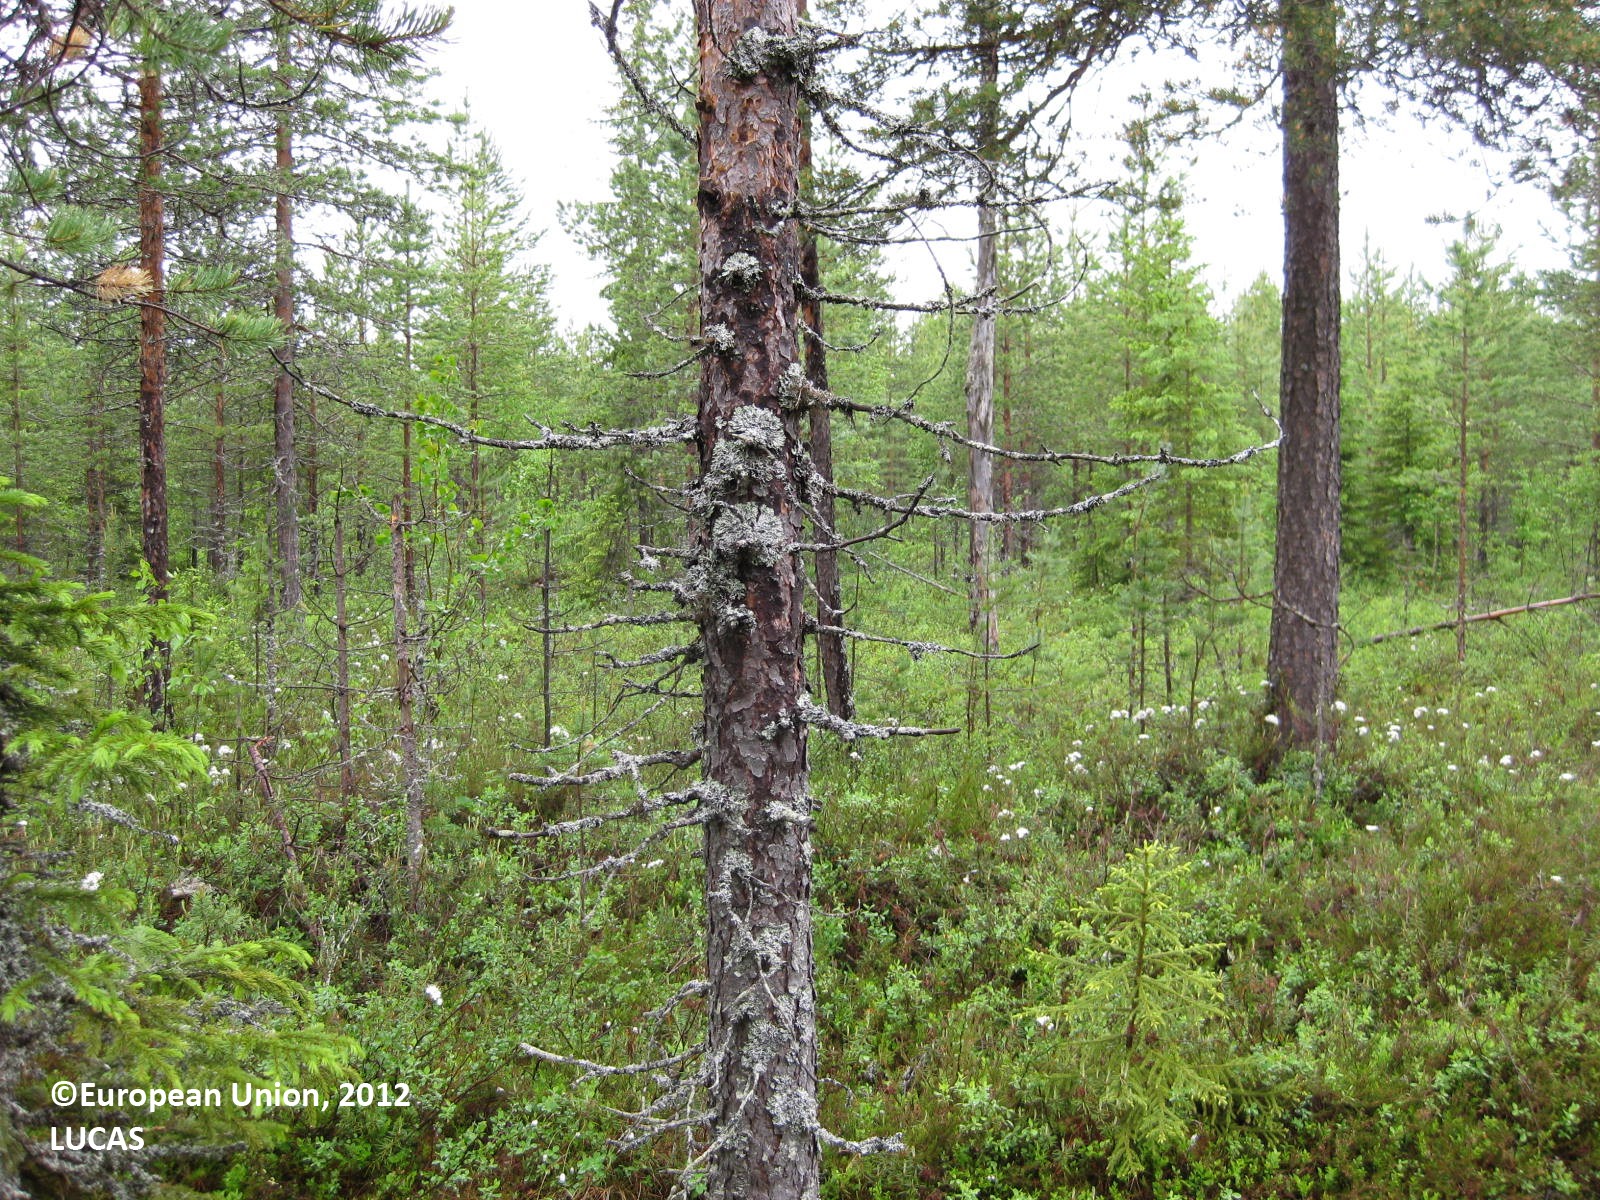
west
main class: Woodland
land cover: Pine dominated coniferous woodland
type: boreal forest
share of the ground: 50 - 75 %
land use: Forestry
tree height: > 5 m
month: June
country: FI
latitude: 65.3006
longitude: 29.3931
